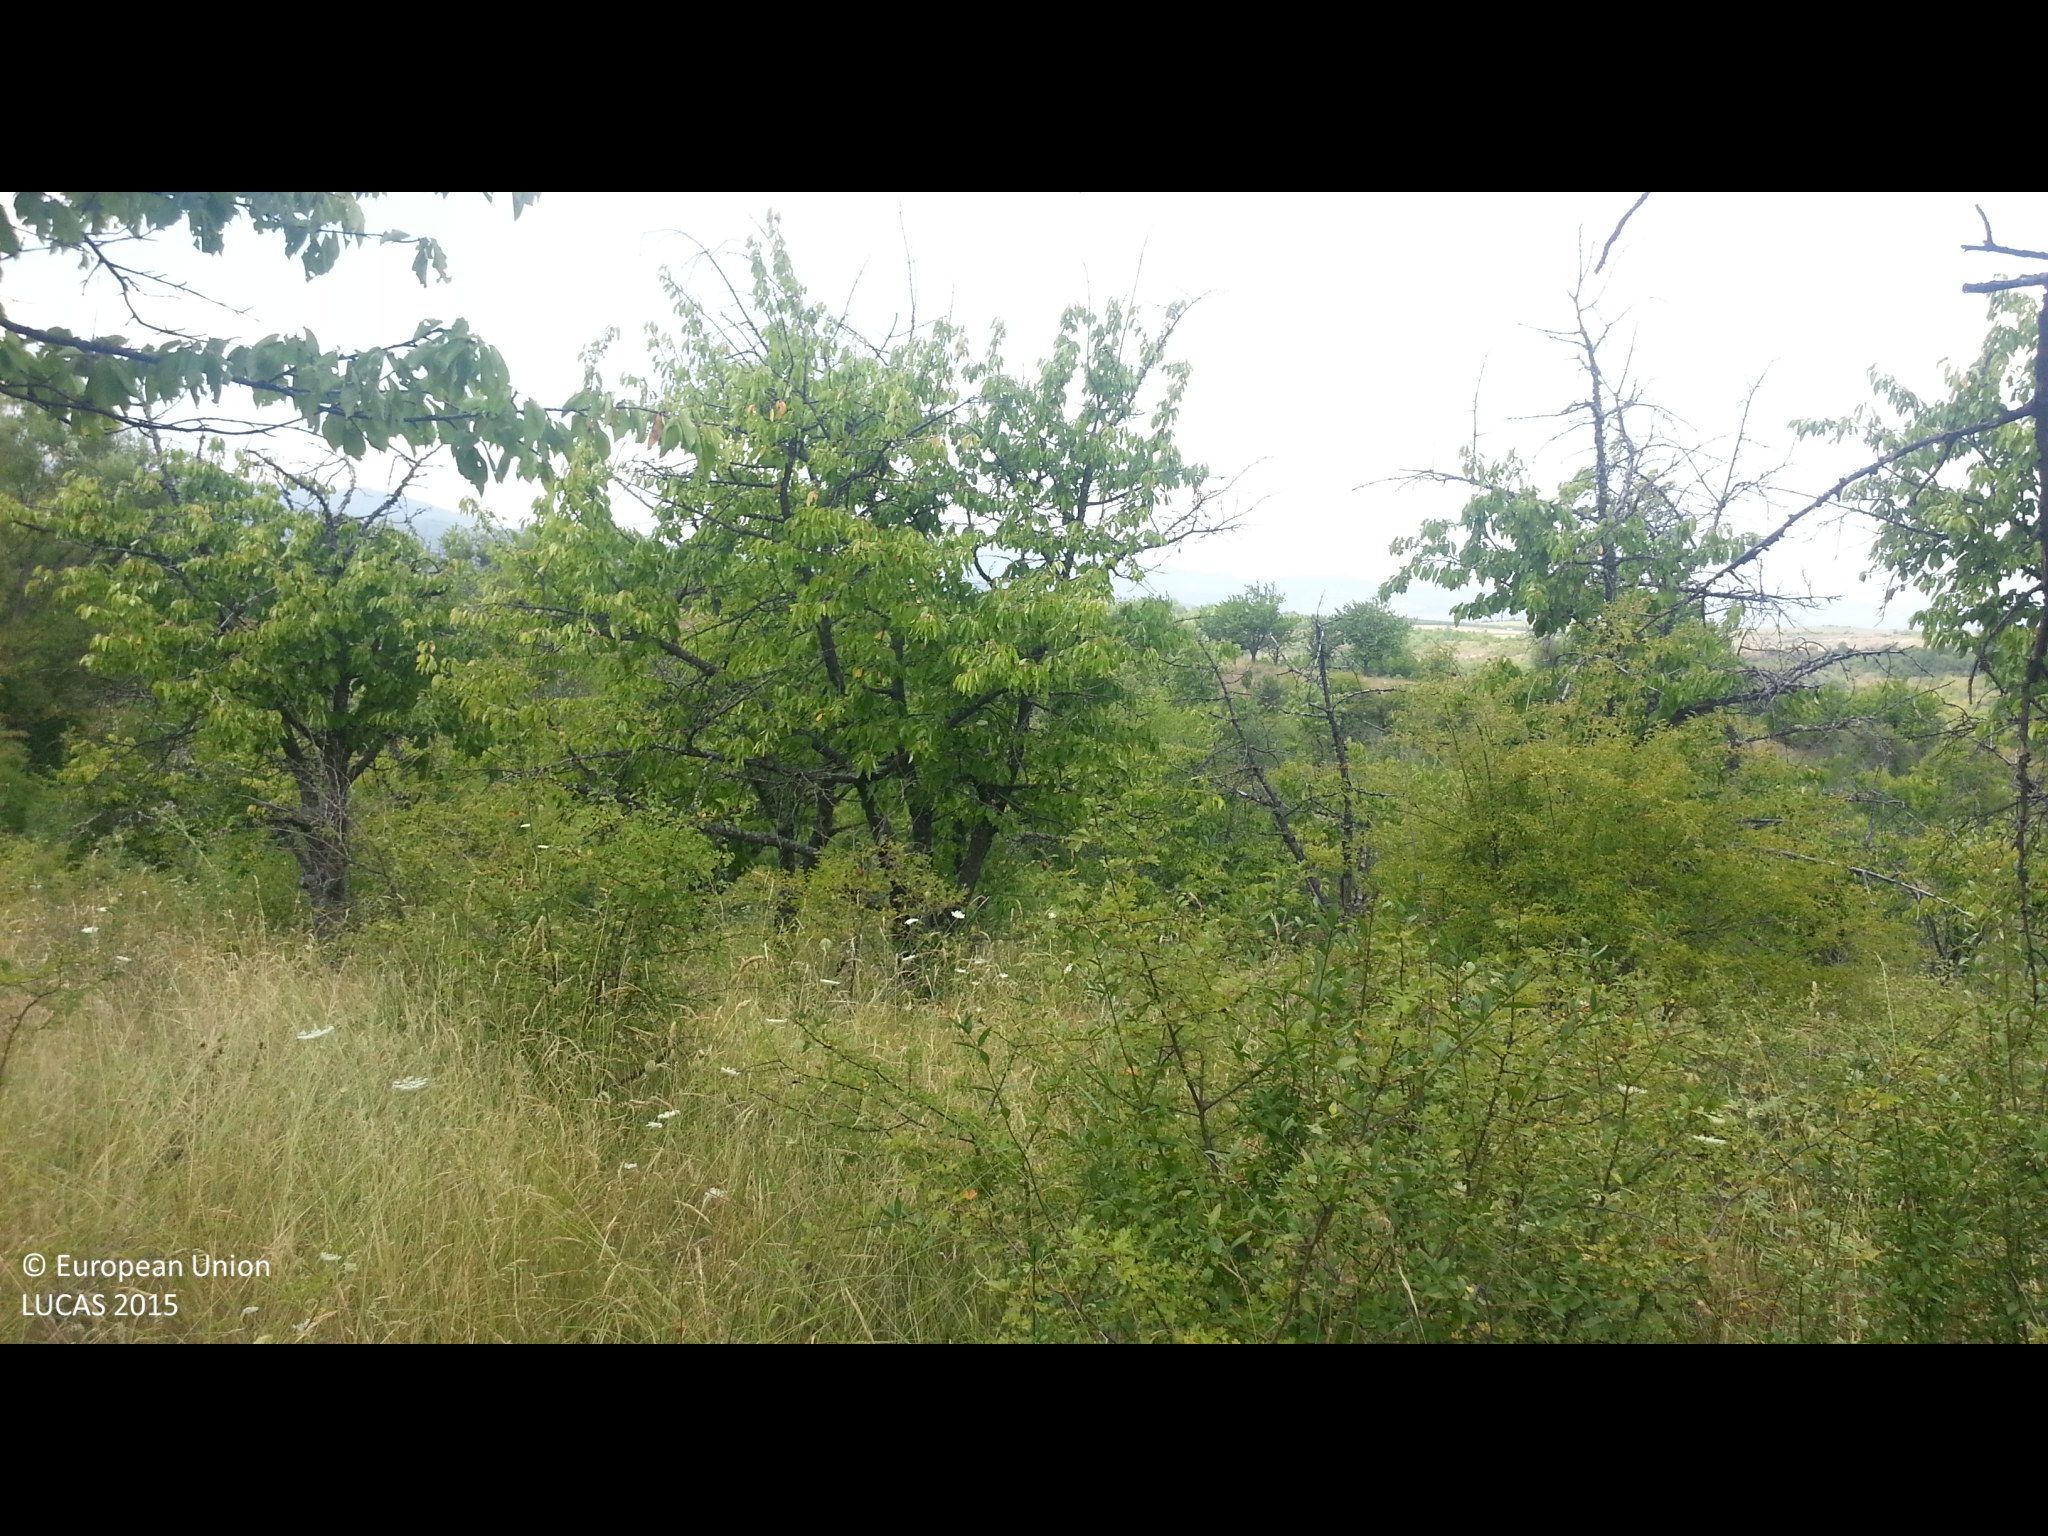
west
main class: Cropland
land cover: Cherry fruit
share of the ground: 25 - 50 %
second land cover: Shrubland without tree cover
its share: 50 - 75 %
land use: Agriculture (excluding fallow land and kitchen gardens)
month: August
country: BG
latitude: 42.2421
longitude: 22.7836
